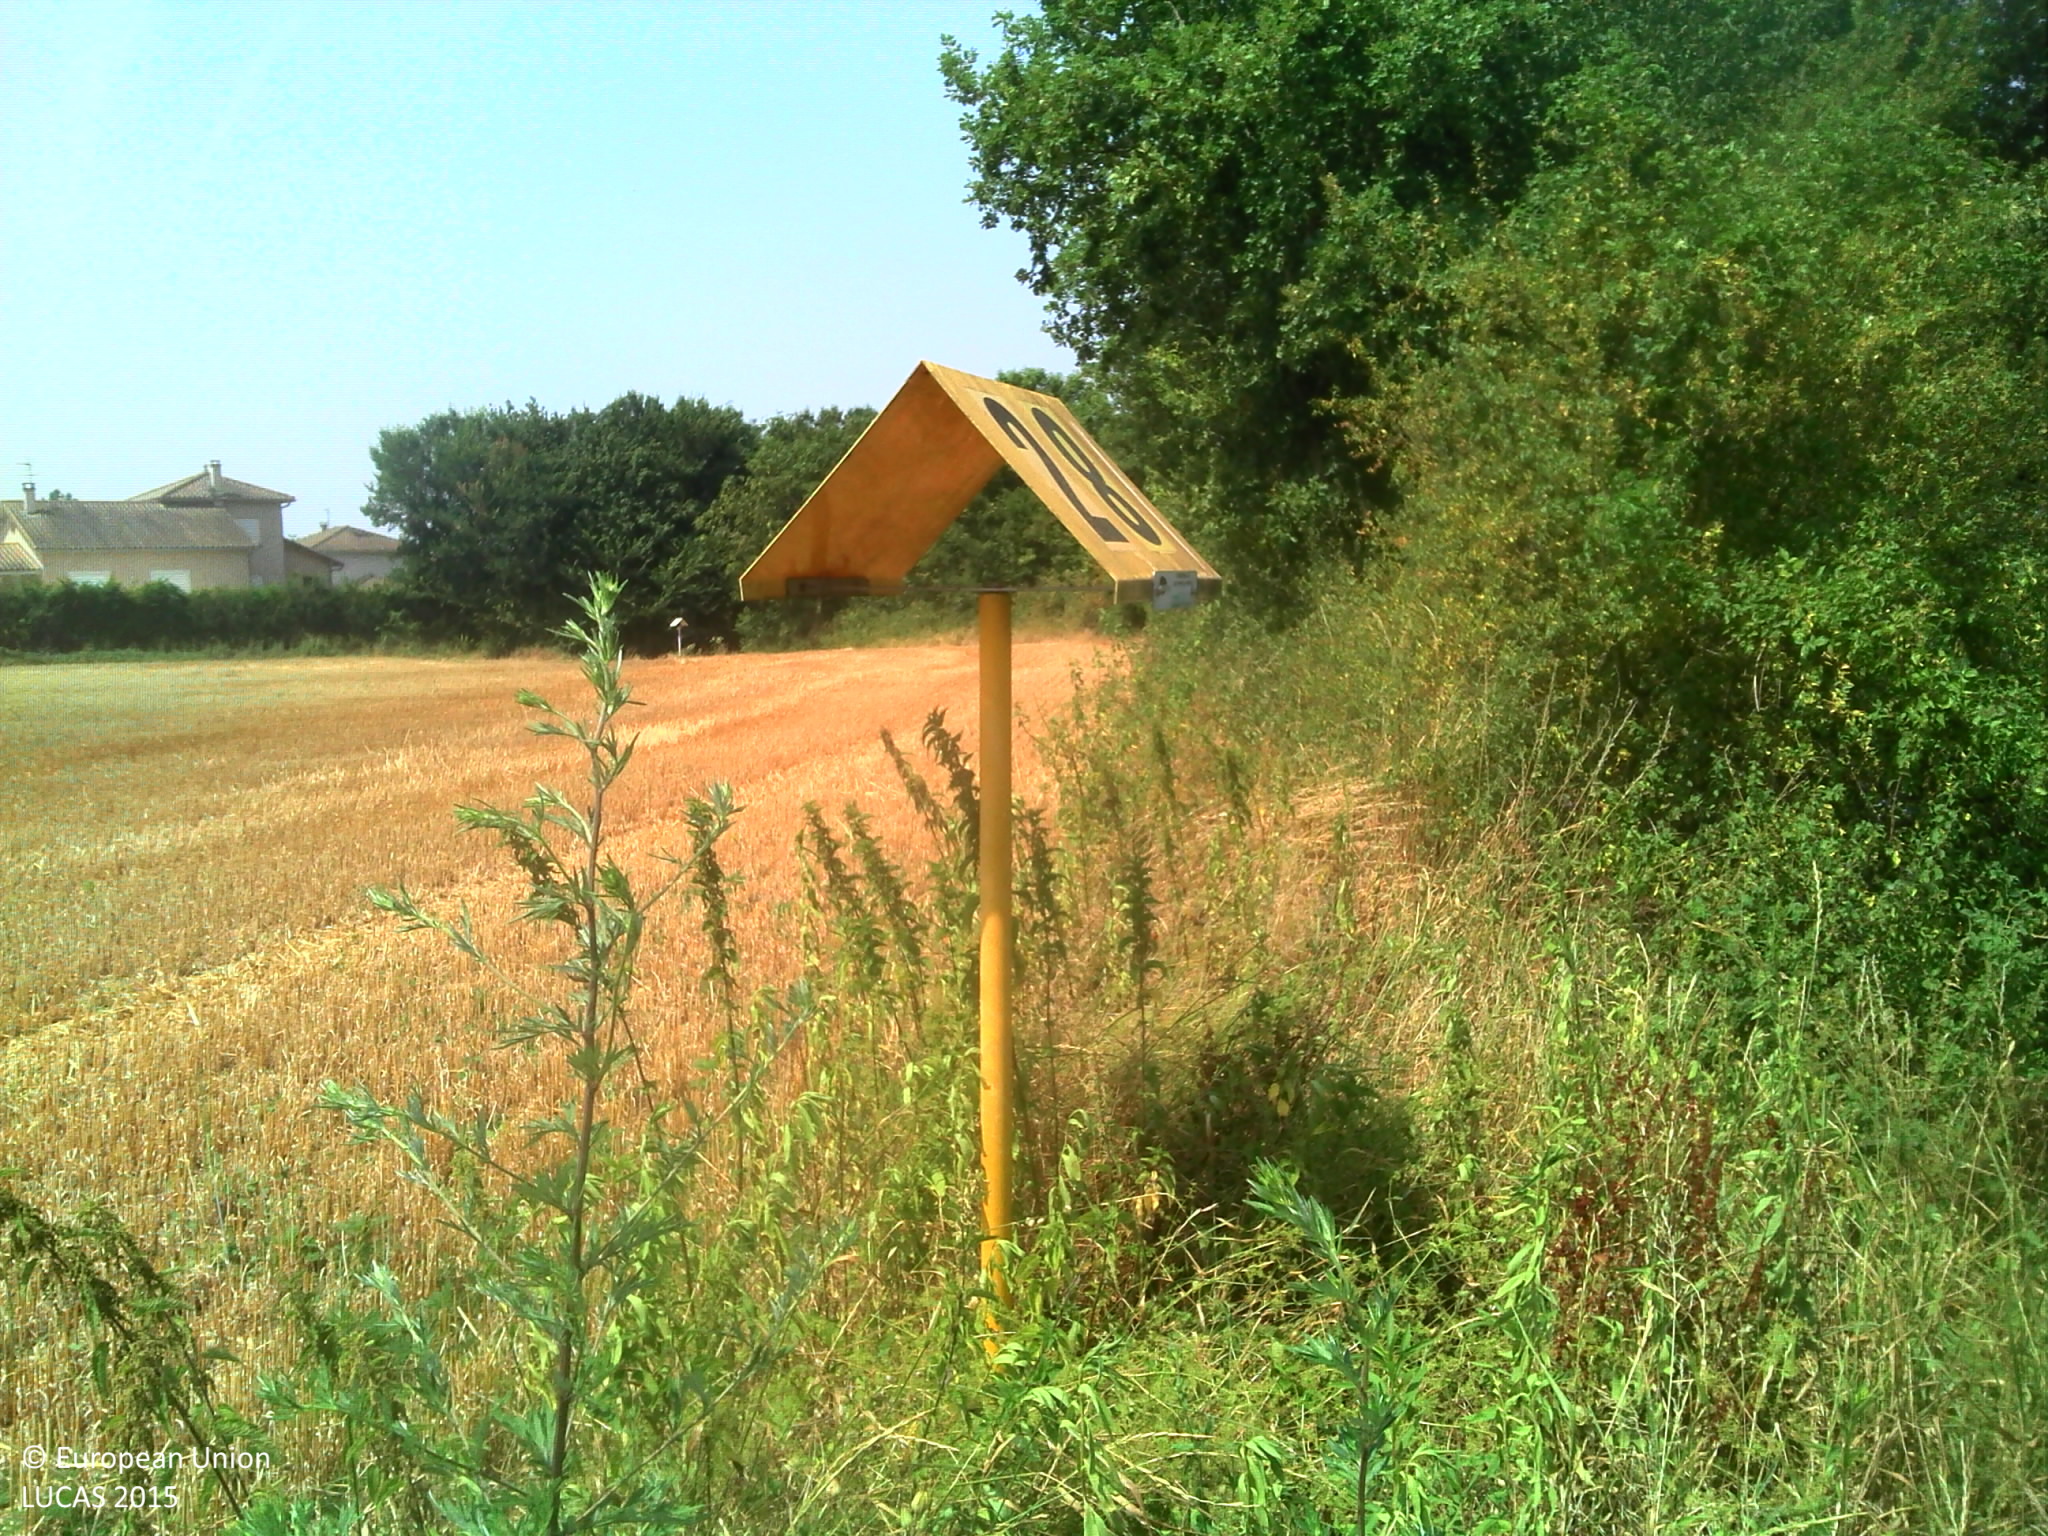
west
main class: Cropland
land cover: Maize
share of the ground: 50 - 75 %
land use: Agriculture (excluding fallow land and kitchen gardens)
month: July
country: FR
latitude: 45.8071
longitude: 5.1269
